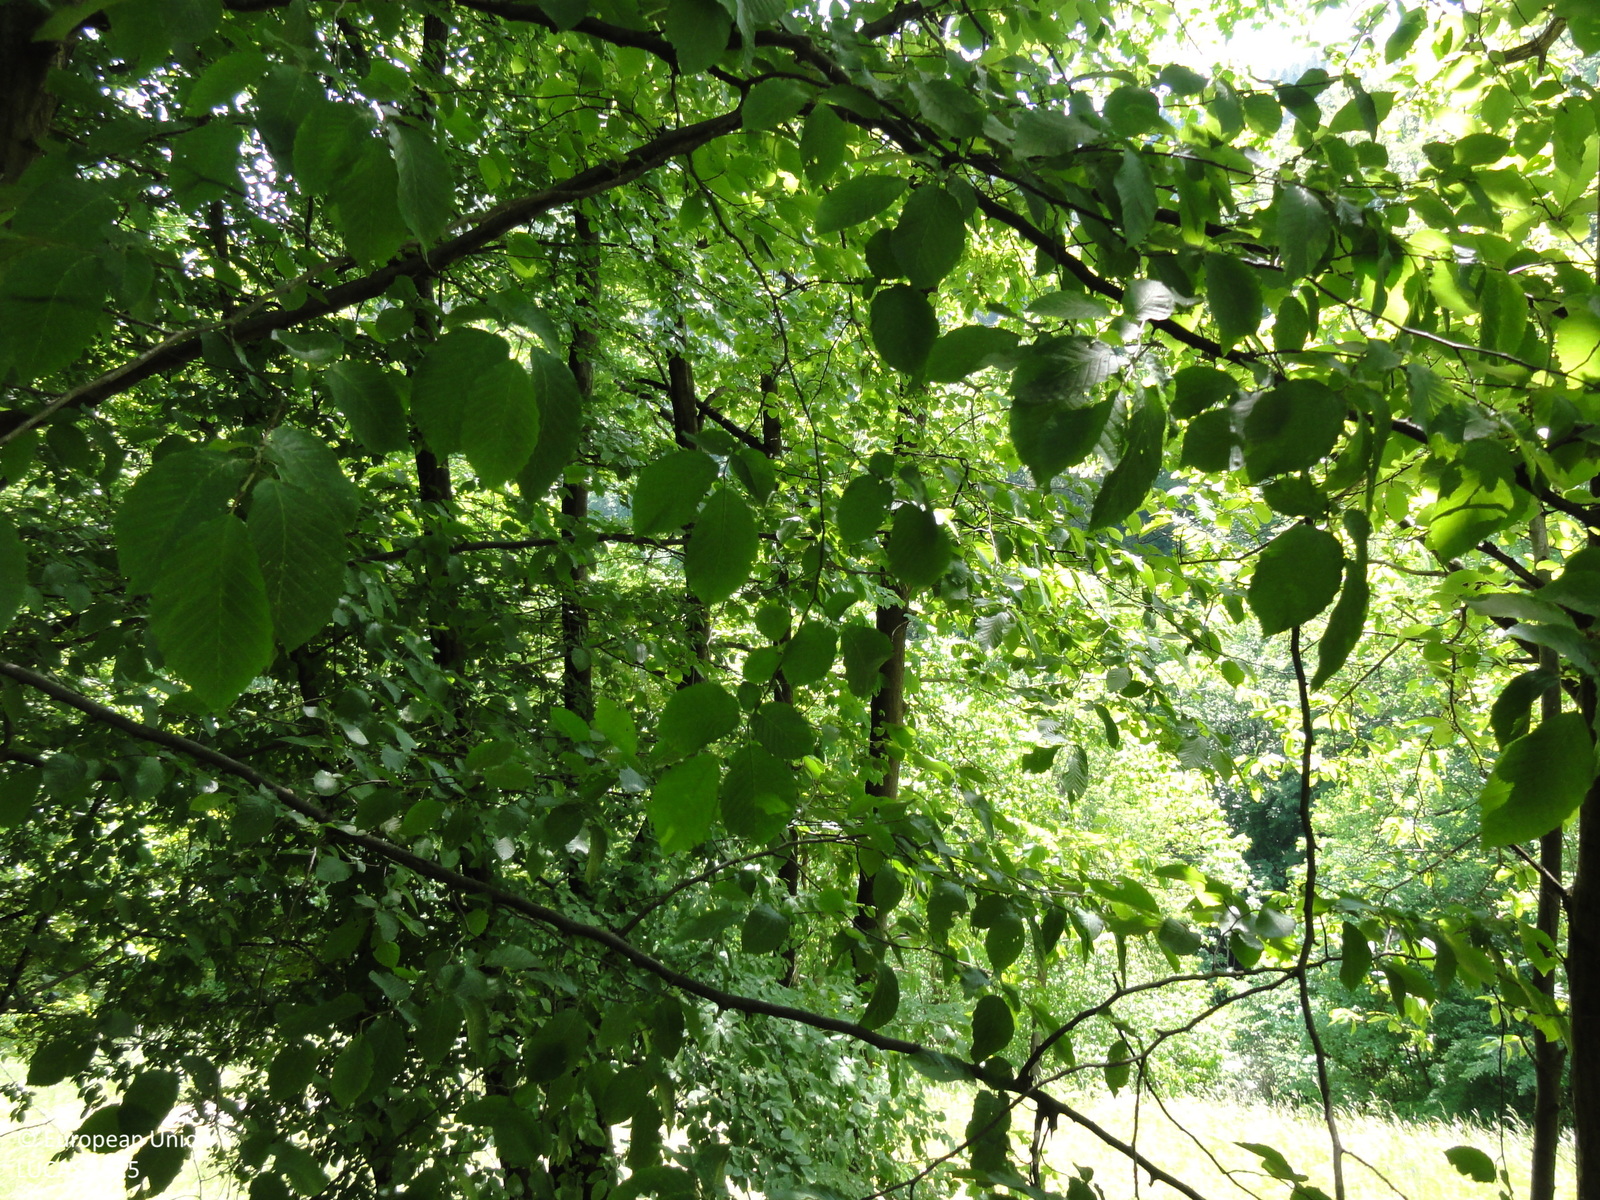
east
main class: Woodland
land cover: Broadleaved woodland
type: mesophytic deciduous forest
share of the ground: > 75 %
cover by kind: broadleaved forest trees 100 %
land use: Forestry
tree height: > 5 m
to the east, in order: Broadleaved woodland; Grassland without tree/shrub cover; Tracks; Broadleaved woodland; Rivers and streams; Broadleaved woodland; Tracks; Rivers and streams; Spruce dominated mixed woodland; Tracks; Spruce dominated mixed woodland
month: May
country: SI
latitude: 46.2044
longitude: 15.2465
